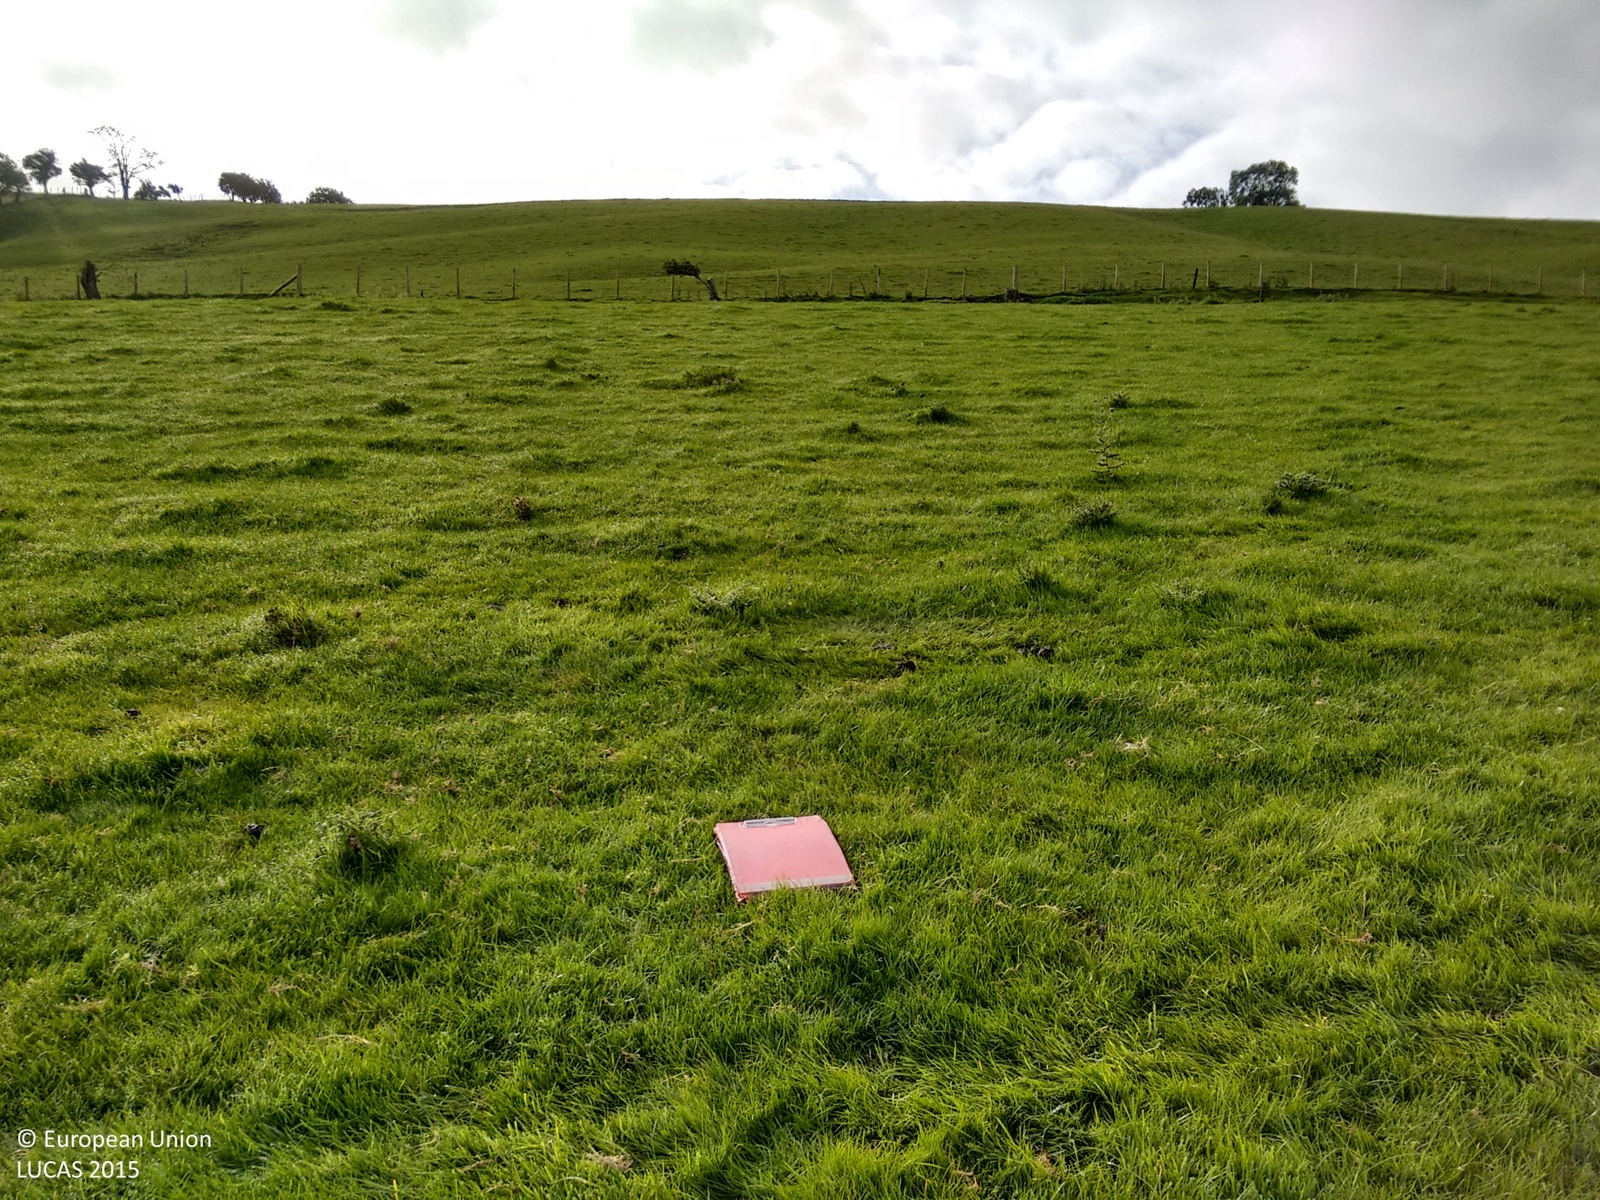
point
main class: Grassland
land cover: Grassland without tree/shrub cover
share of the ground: > 75 %
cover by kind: herbaceous plants 100 %
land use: Agriculture (excluding fallow land and kitchen gardens)
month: September
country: GB
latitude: 52.6096
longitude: -3.2974
